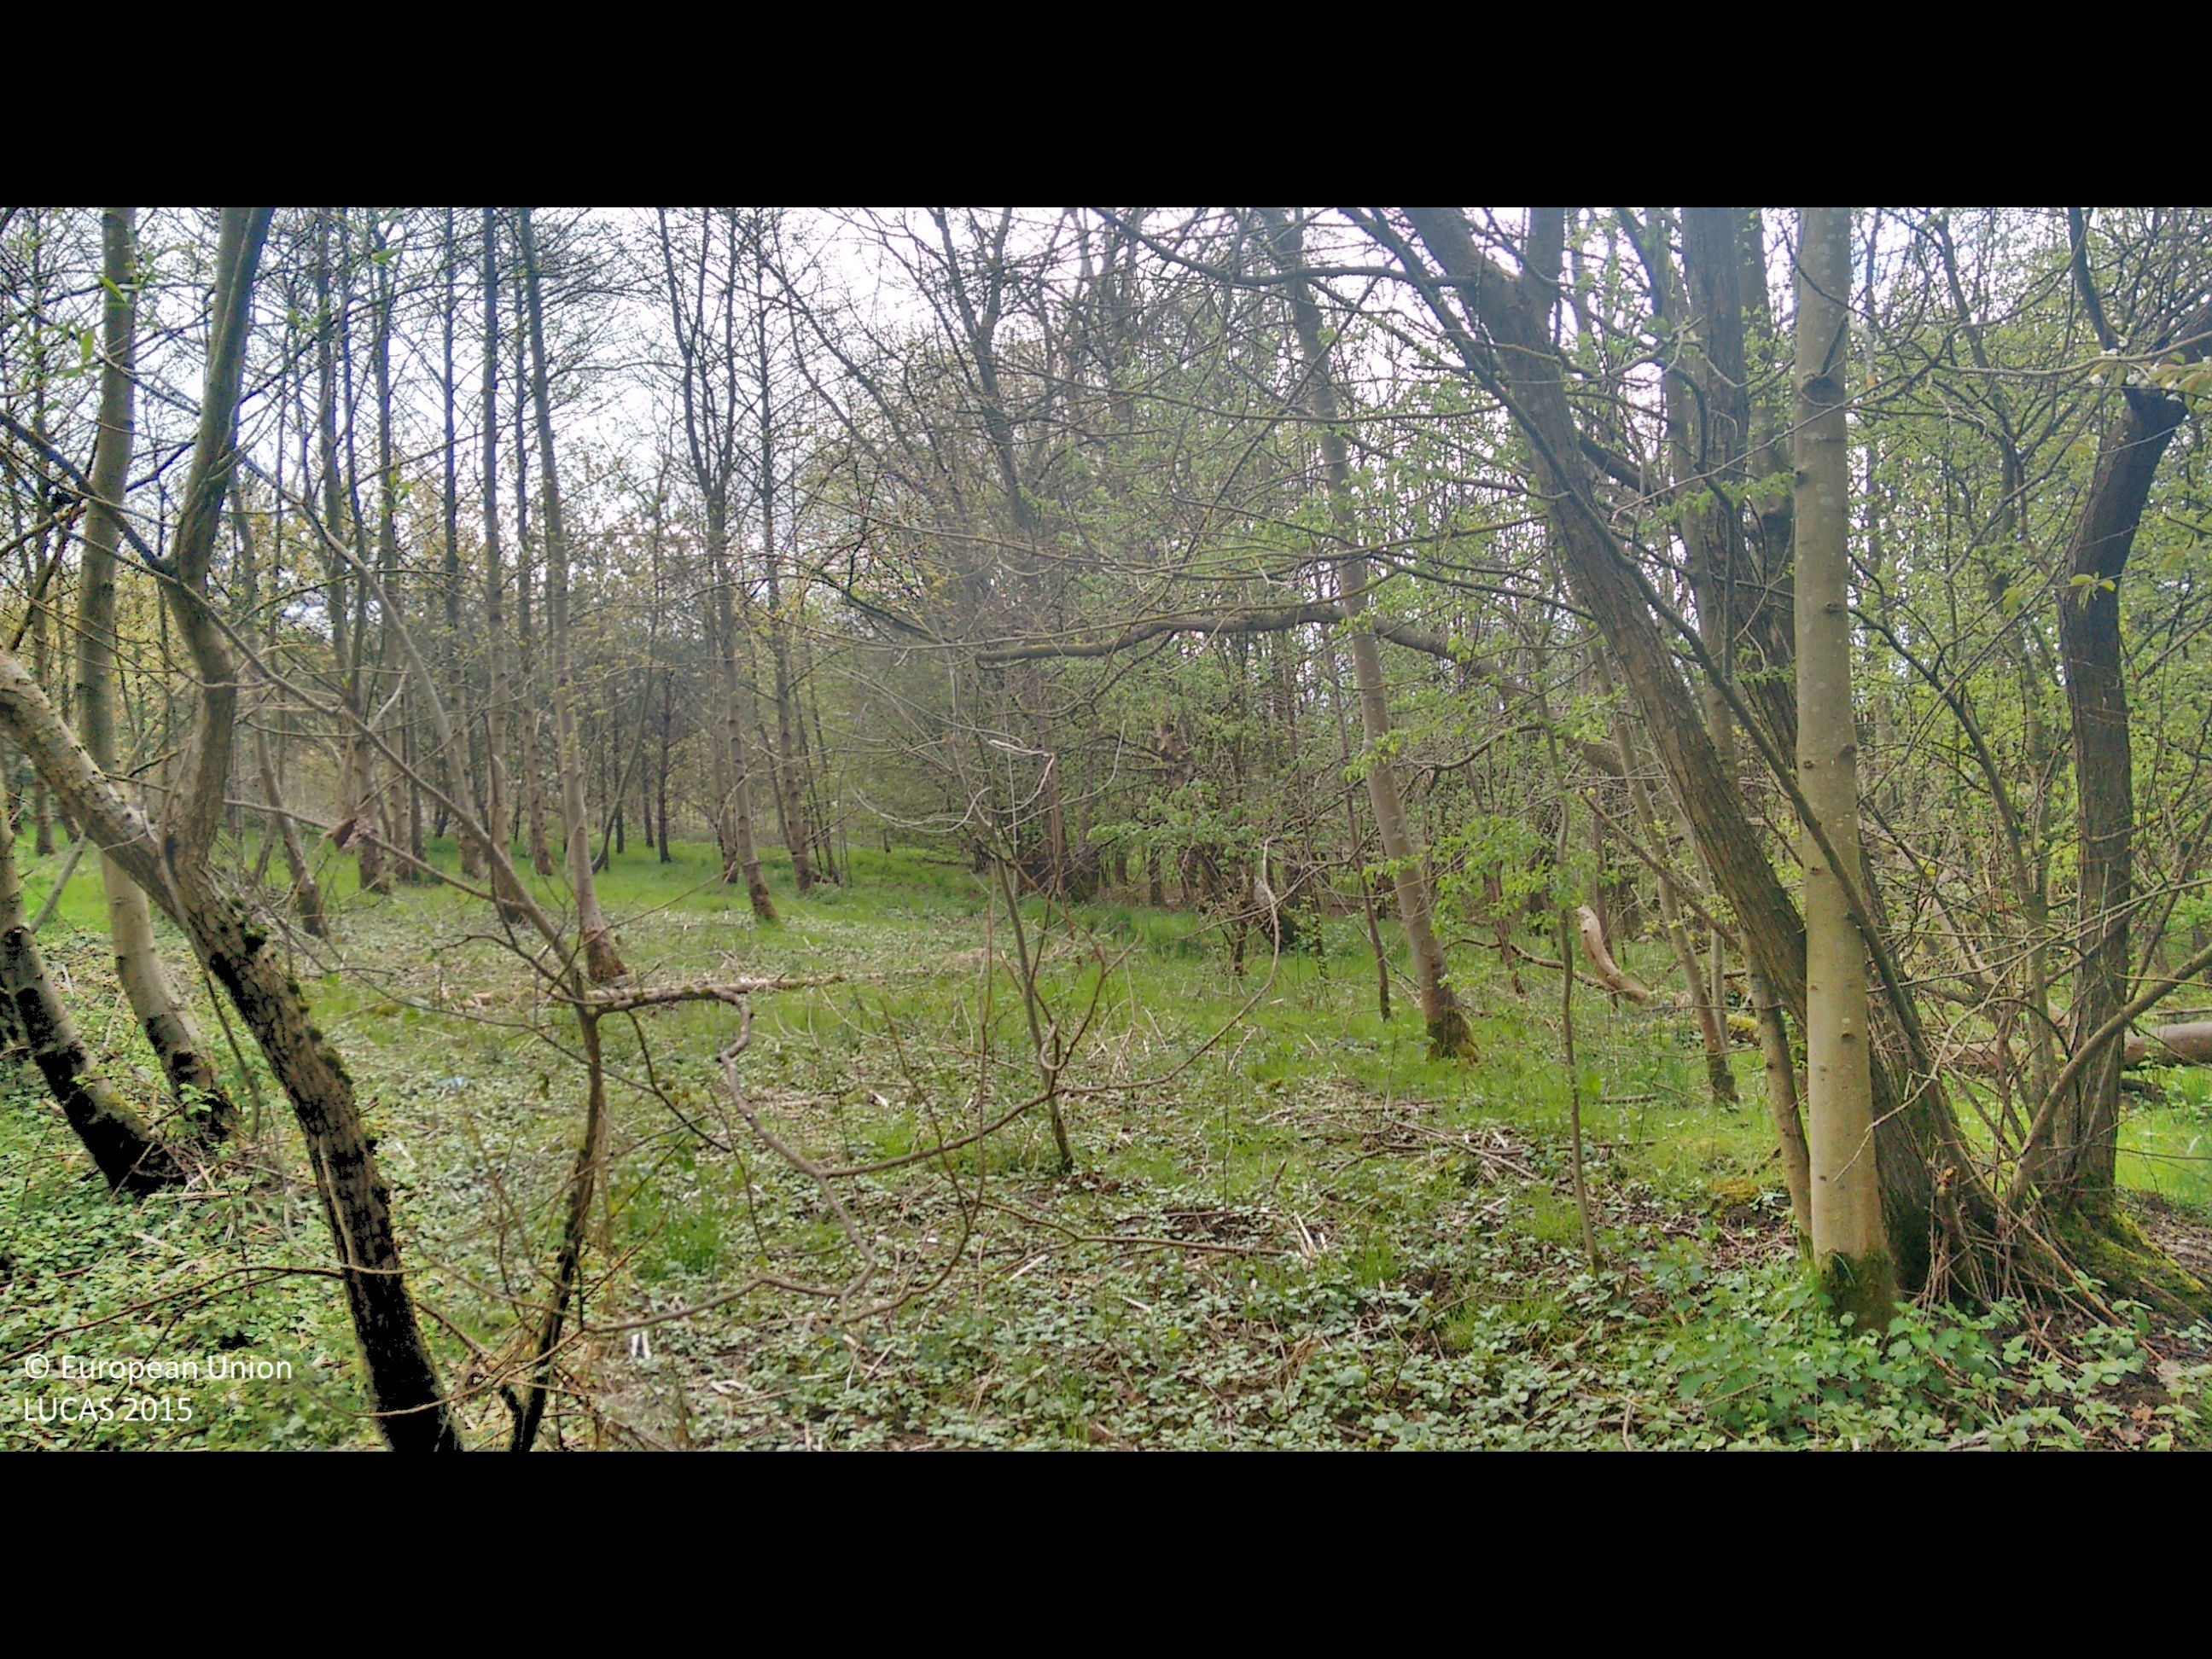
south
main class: Woodland
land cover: Pine dominated mixed woodland
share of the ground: > 75 %
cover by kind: coniferous forest trees 75 %, broadleaved forest trees 25 %
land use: Semi-natural and natural areas not in use
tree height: > 5 m
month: April
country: GB
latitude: 53.7812
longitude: -2.2165
